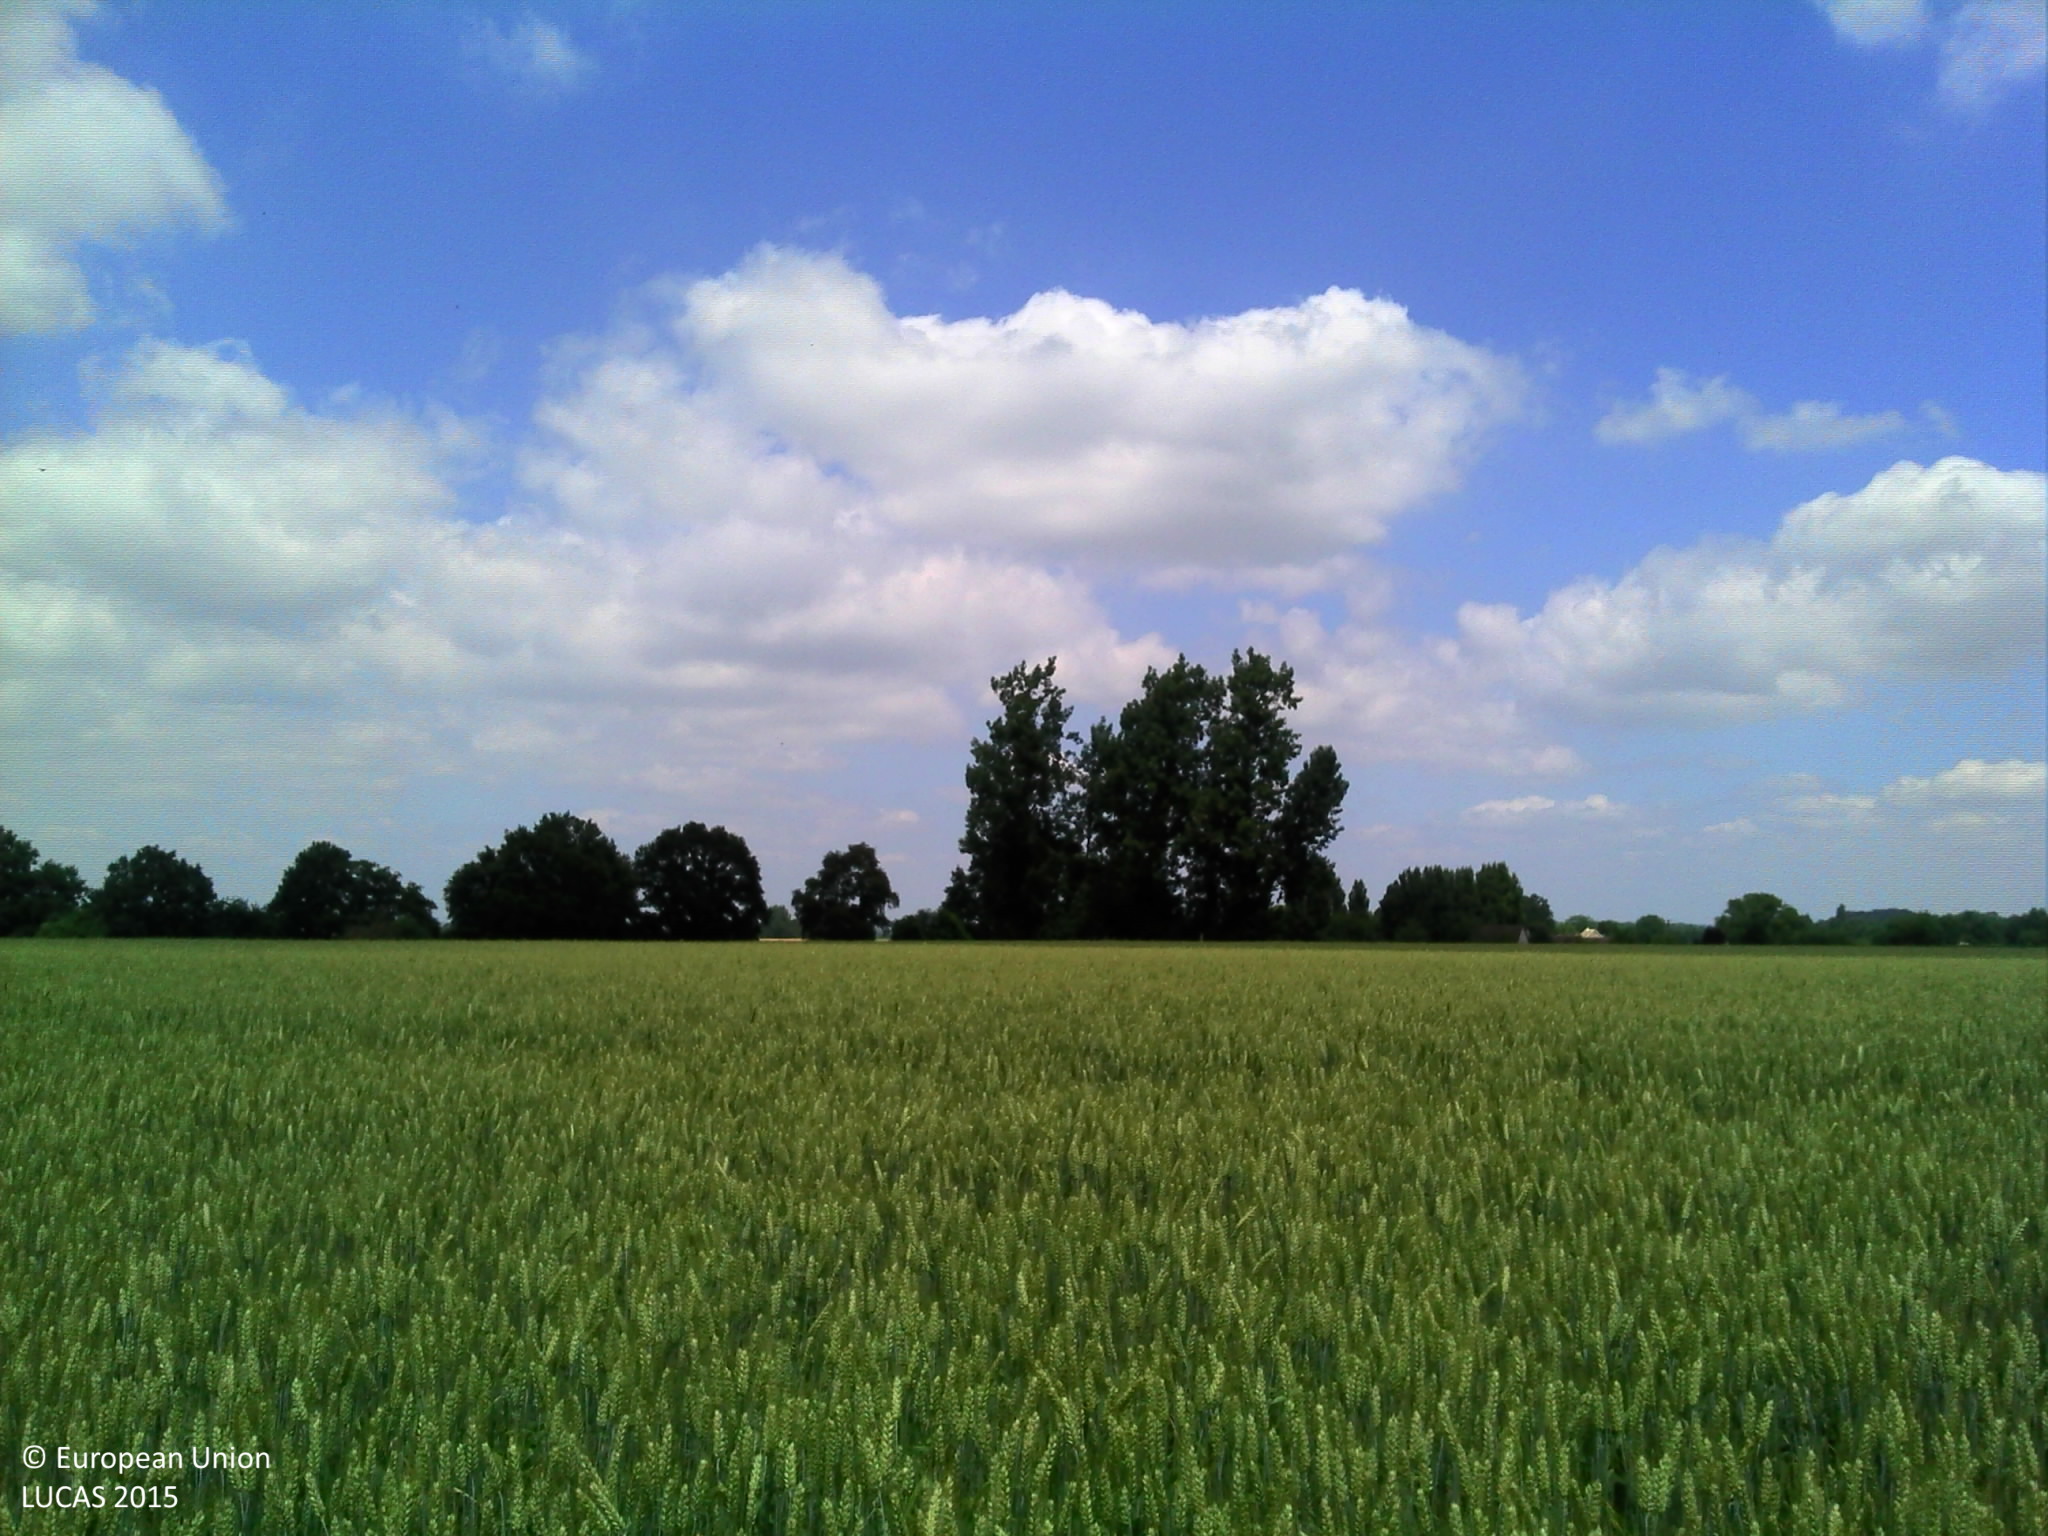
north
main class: Cropland
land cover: Common wheat
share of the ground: > 75 %
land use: Agriculture (excluding fallow land and kitchen gardens)
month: June
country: FR
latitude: 48.2246
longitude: 0.2413
